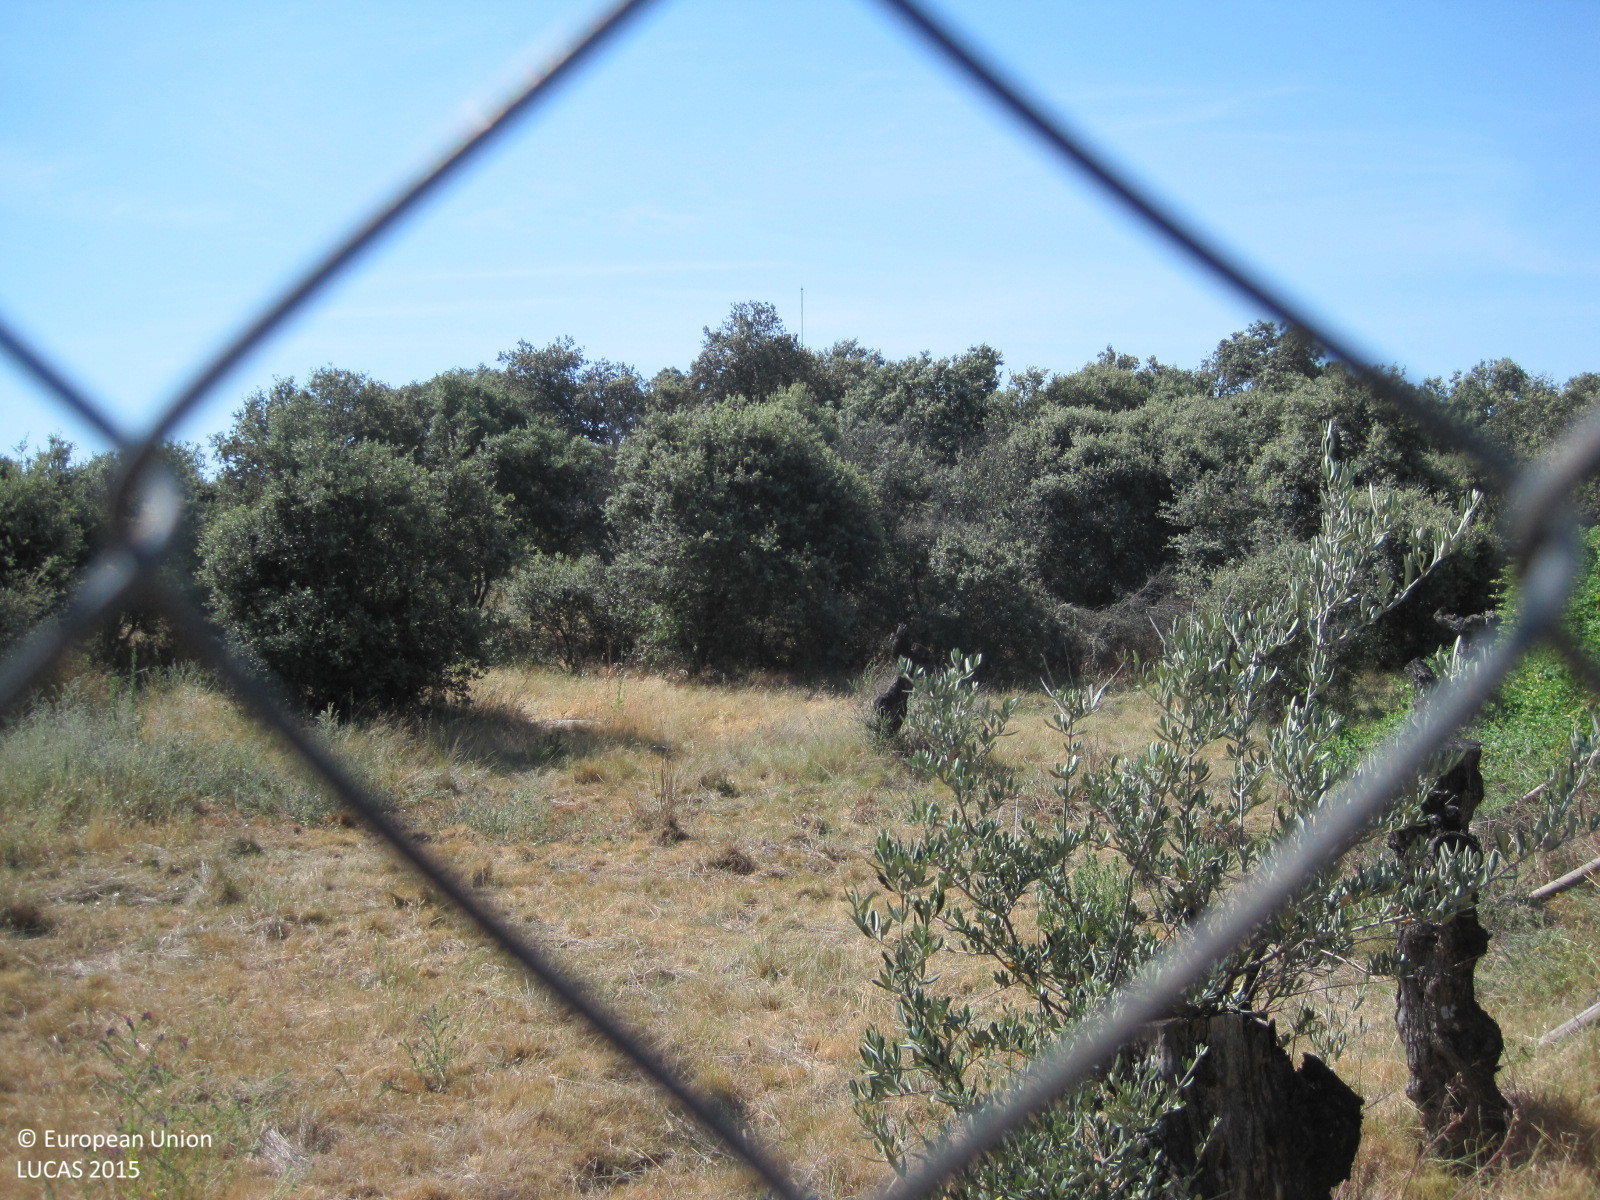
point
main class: Woodland
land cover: Broadleaved woodland
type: broadleaved evergreen forest
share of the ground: 50 - 75 %
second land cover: Grassland without tree/shrub cover
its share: 50 - 75 %
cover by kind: broadleaved forest trees 90 %, herbaceous plants 10 %
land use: Forestry
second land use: Agriculture (excluding fallow land and kitchen gardens)
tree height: < 5 m
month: June
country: ES
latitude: 40.0901
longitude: -4.8159
